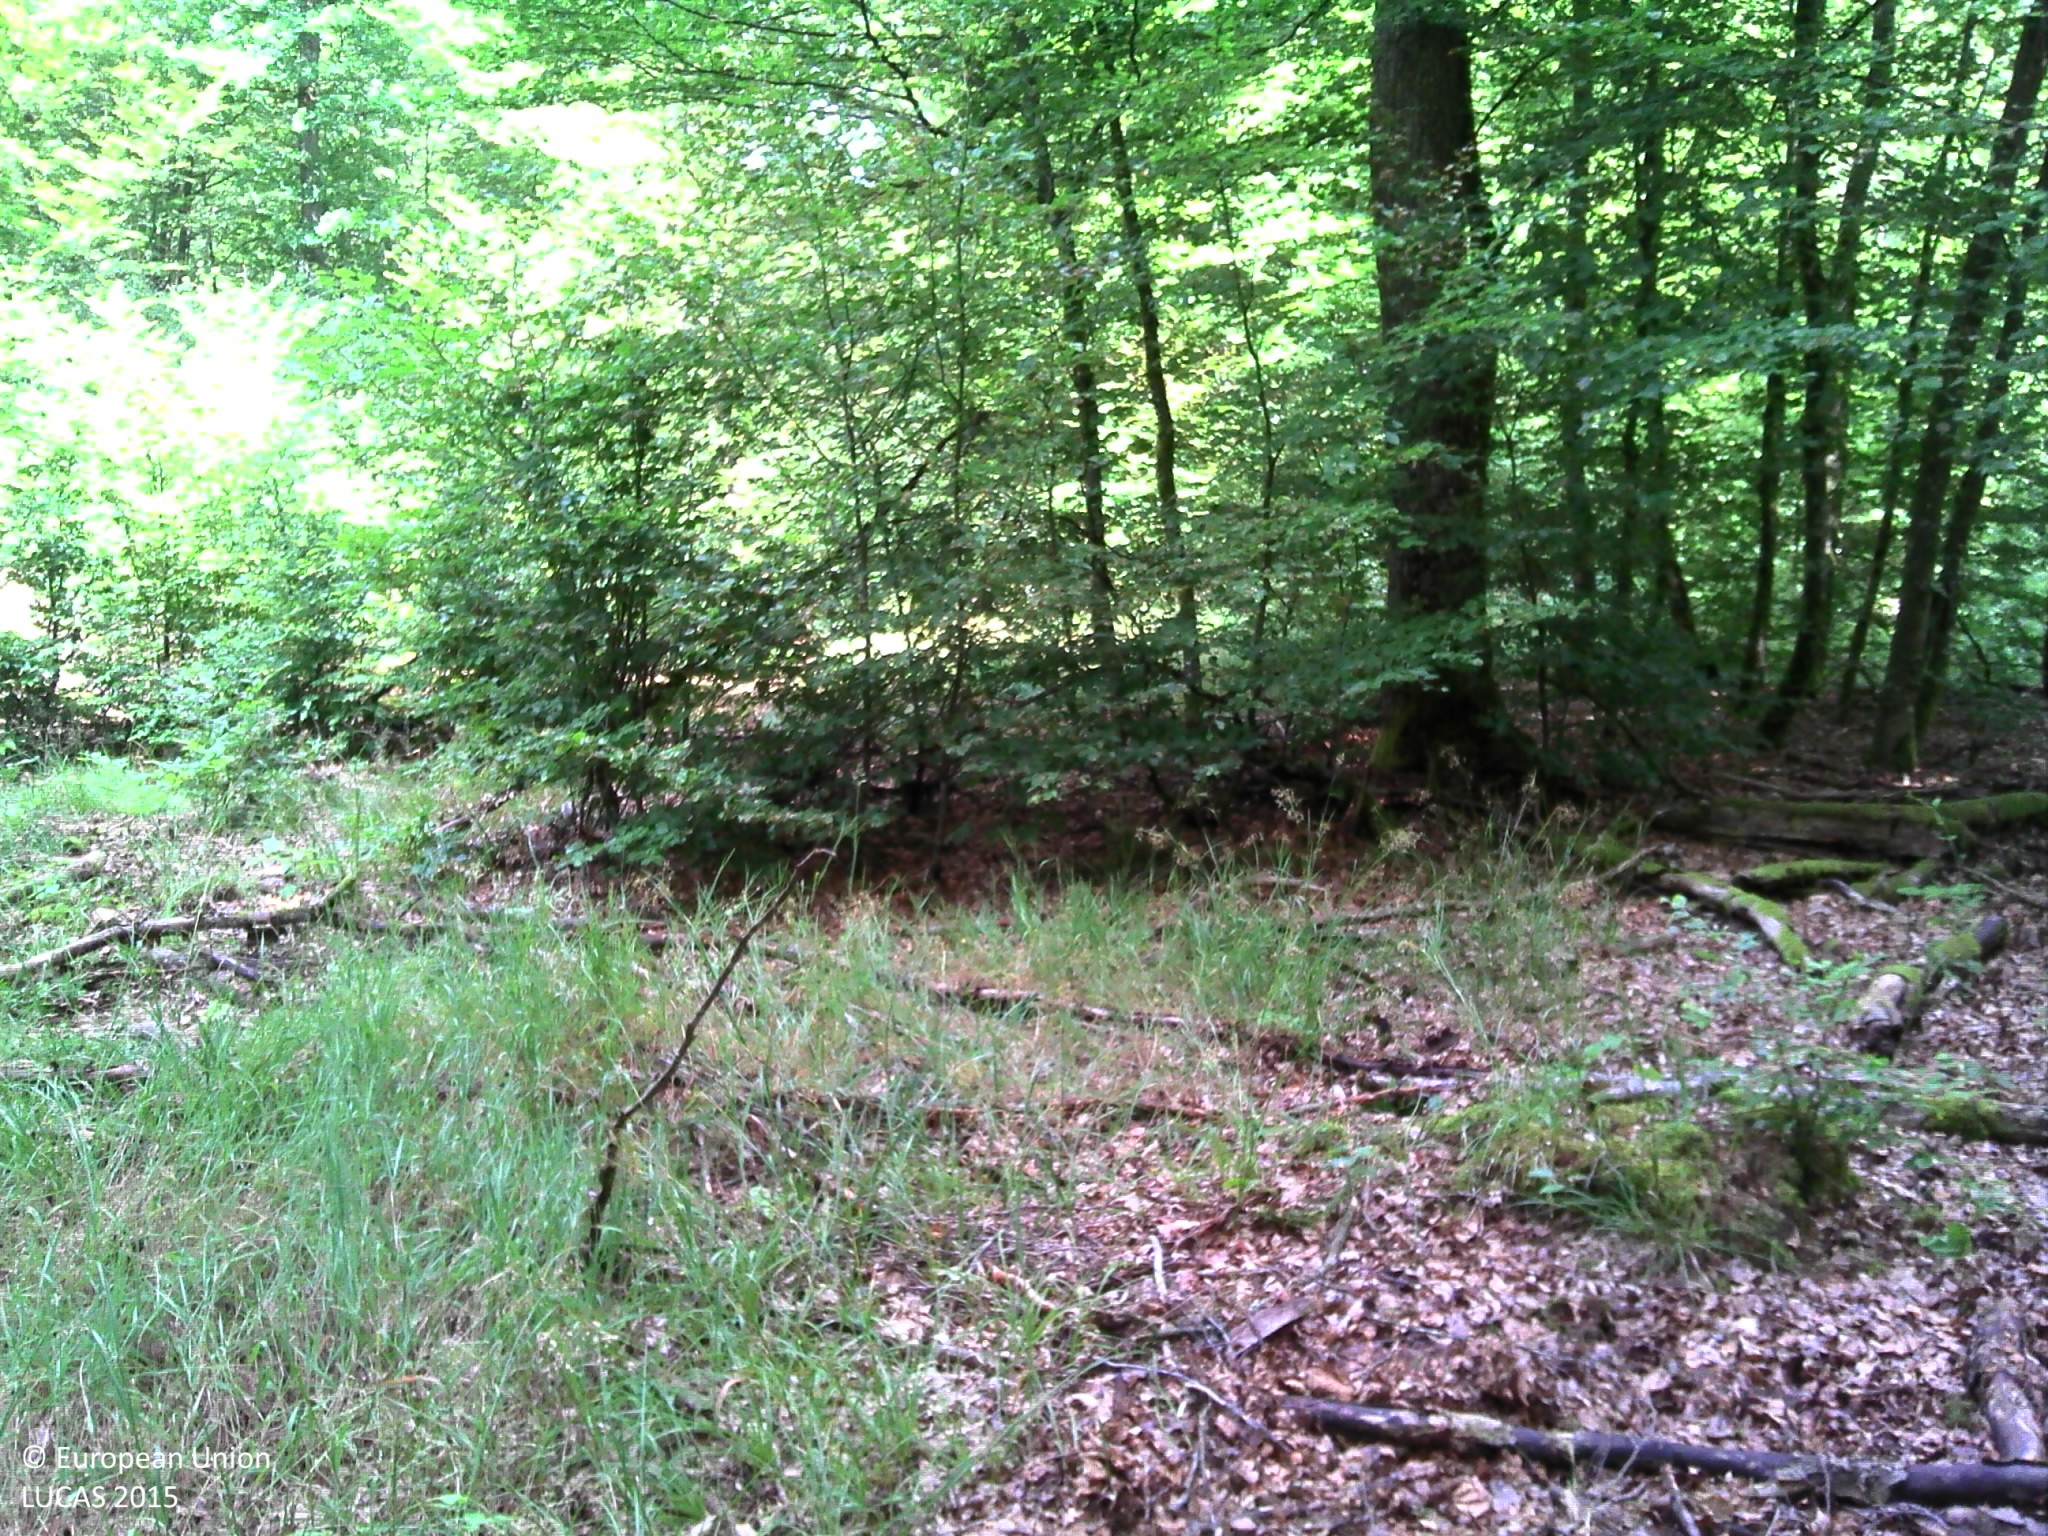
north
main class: Woodland
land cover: Broadleaved woodland
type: acidophilous oak and oak-birch forest
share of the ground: 50 - 75 %
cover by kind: broadleaved forest trees 70 %, herbaceous plants 15 %, shrubs 10 %, unconsolidated bare surface 5 %
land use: Forestry
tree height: > 5 m
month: July
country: BE
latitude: 49.7983
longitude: 5.7337
